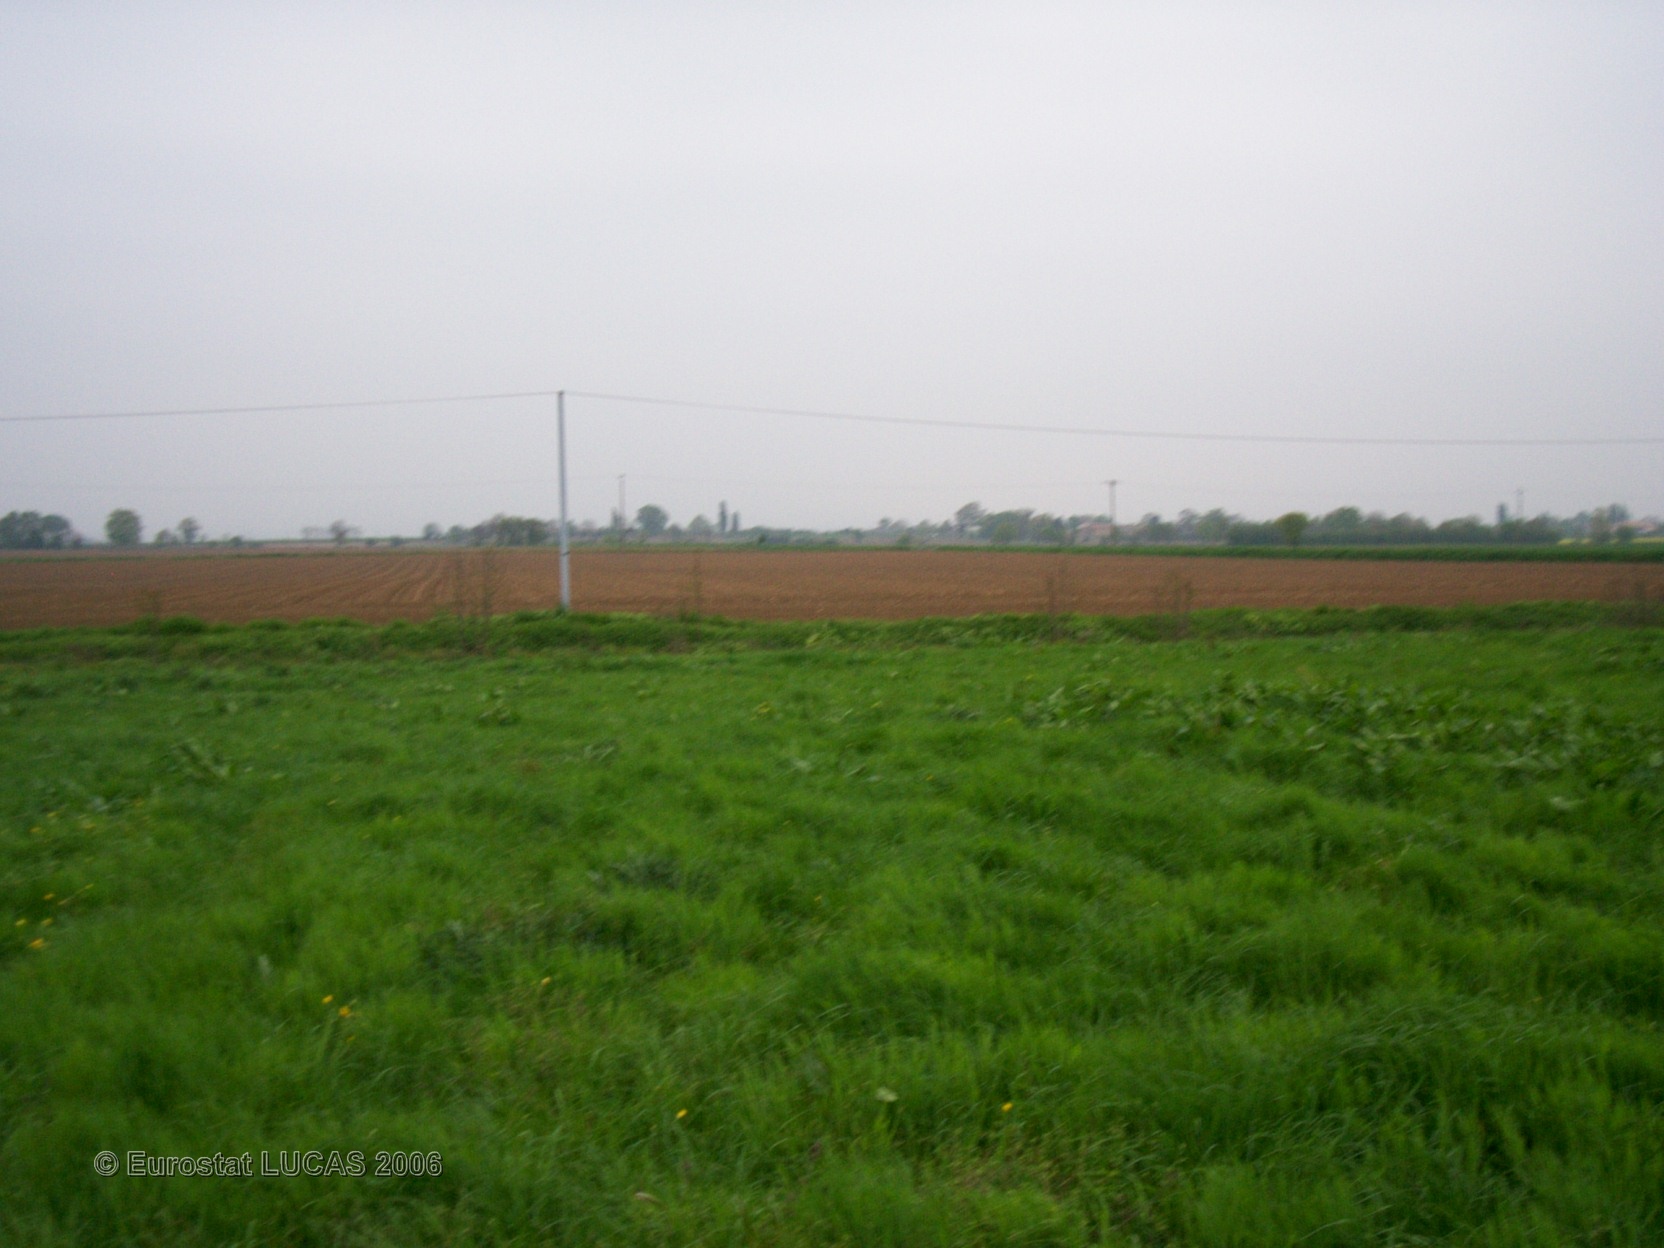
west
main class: Grassland
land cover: Grassland without tree/shrub cover
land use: Agriculture (excluding fallow land and kitchen gardens)
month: April
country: FR
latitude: 46.0261
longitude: 4.7967
